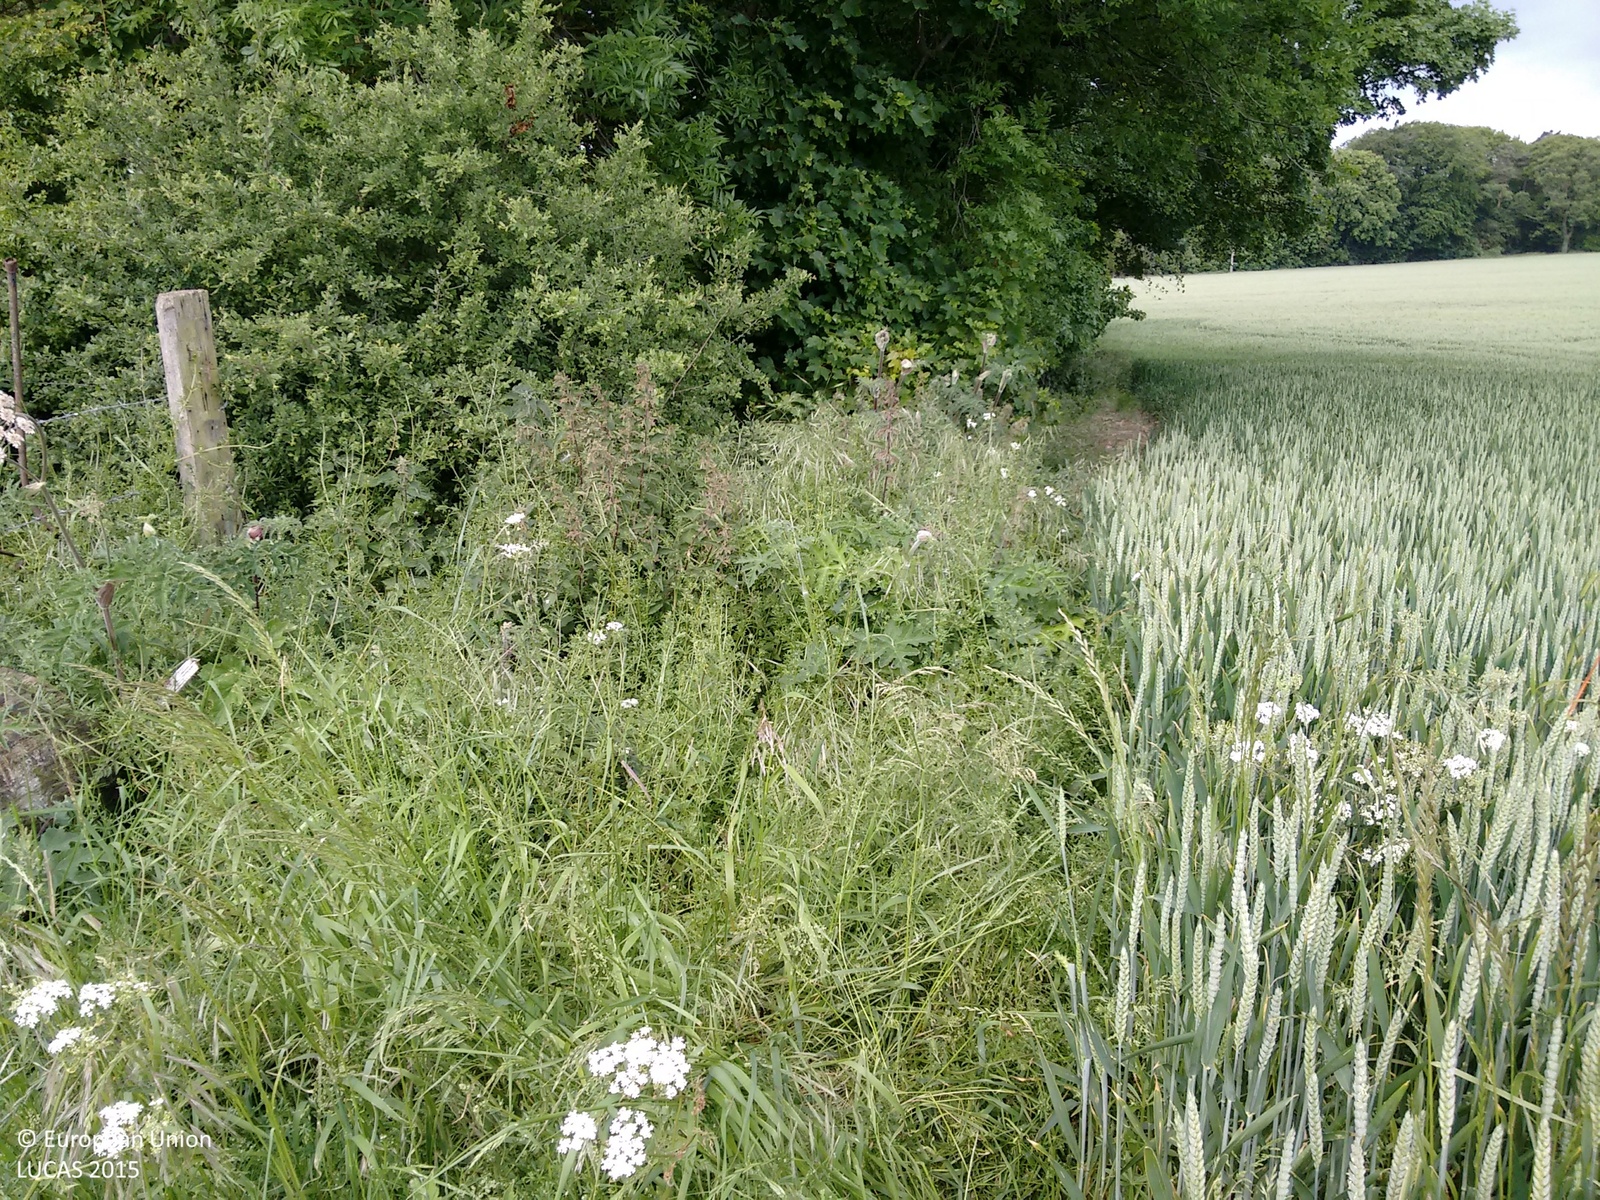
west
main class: Cropland
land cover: Common wheat
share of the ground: > 75 %
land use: Agriculture (excluding fallow land and kitchen gardens)
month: June
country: GB
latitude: 54.4354
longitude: -1.4722
